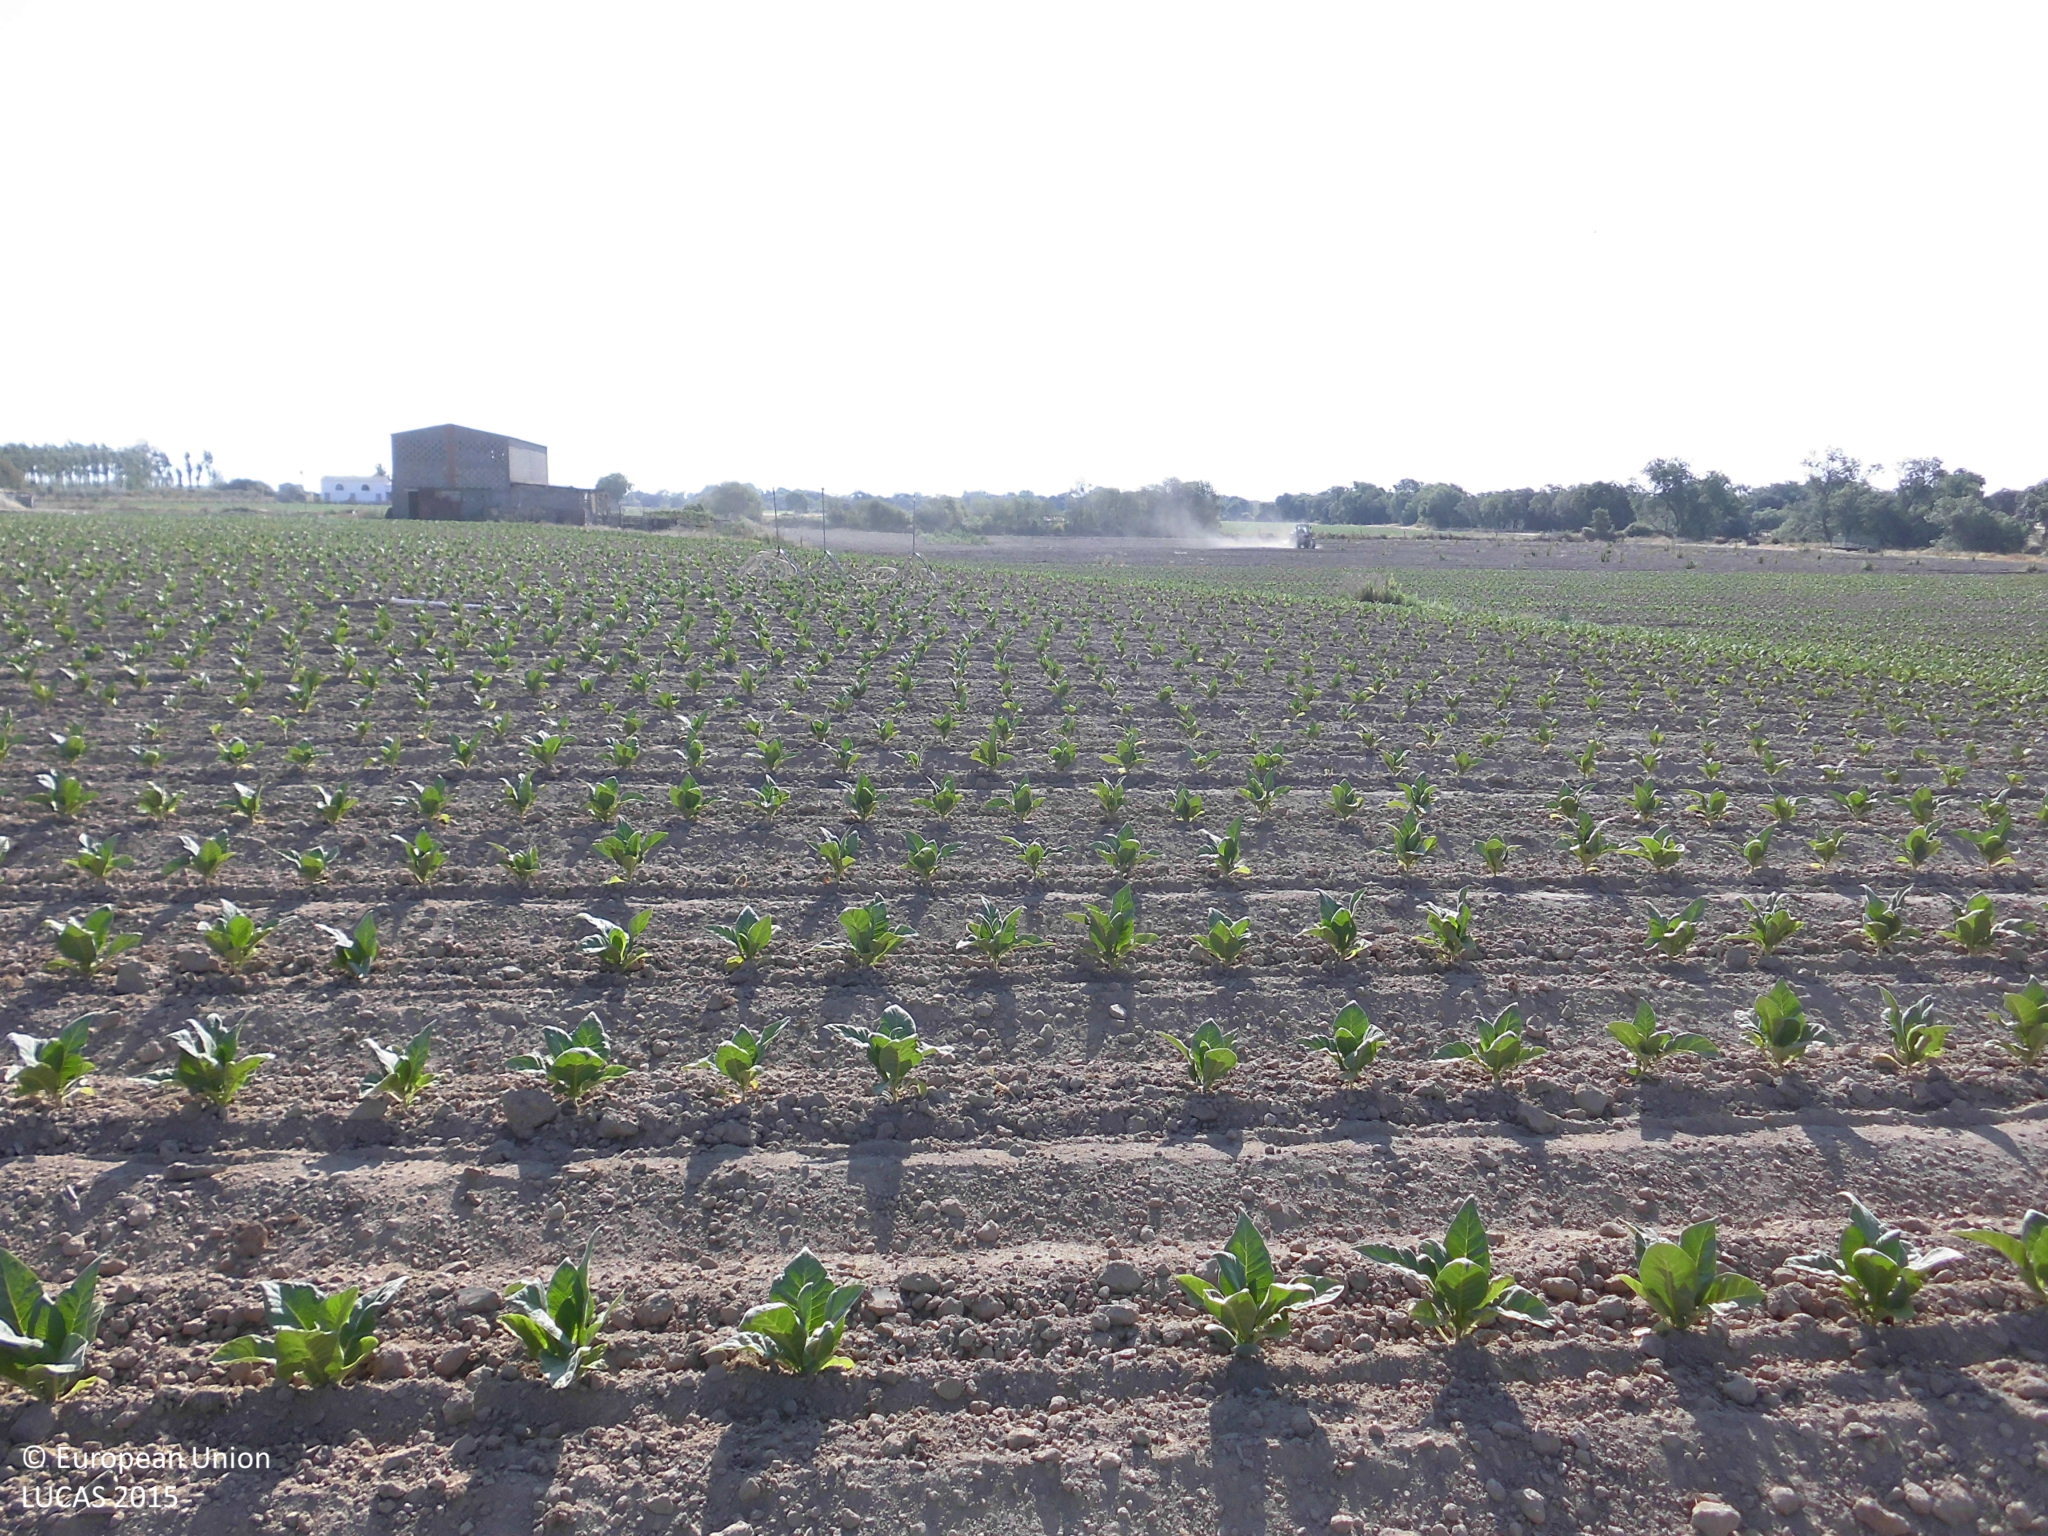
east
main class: Cropland
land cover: Tobacco
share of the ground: 10 - 25 %
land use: Agriculture (excluding fallow land and kitchen gardens)
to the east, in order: Tobacco; Grass margins; Fences; Grassland without tree/shrub cover
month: June
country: ES
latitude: 39.9718
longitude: -5.4552
